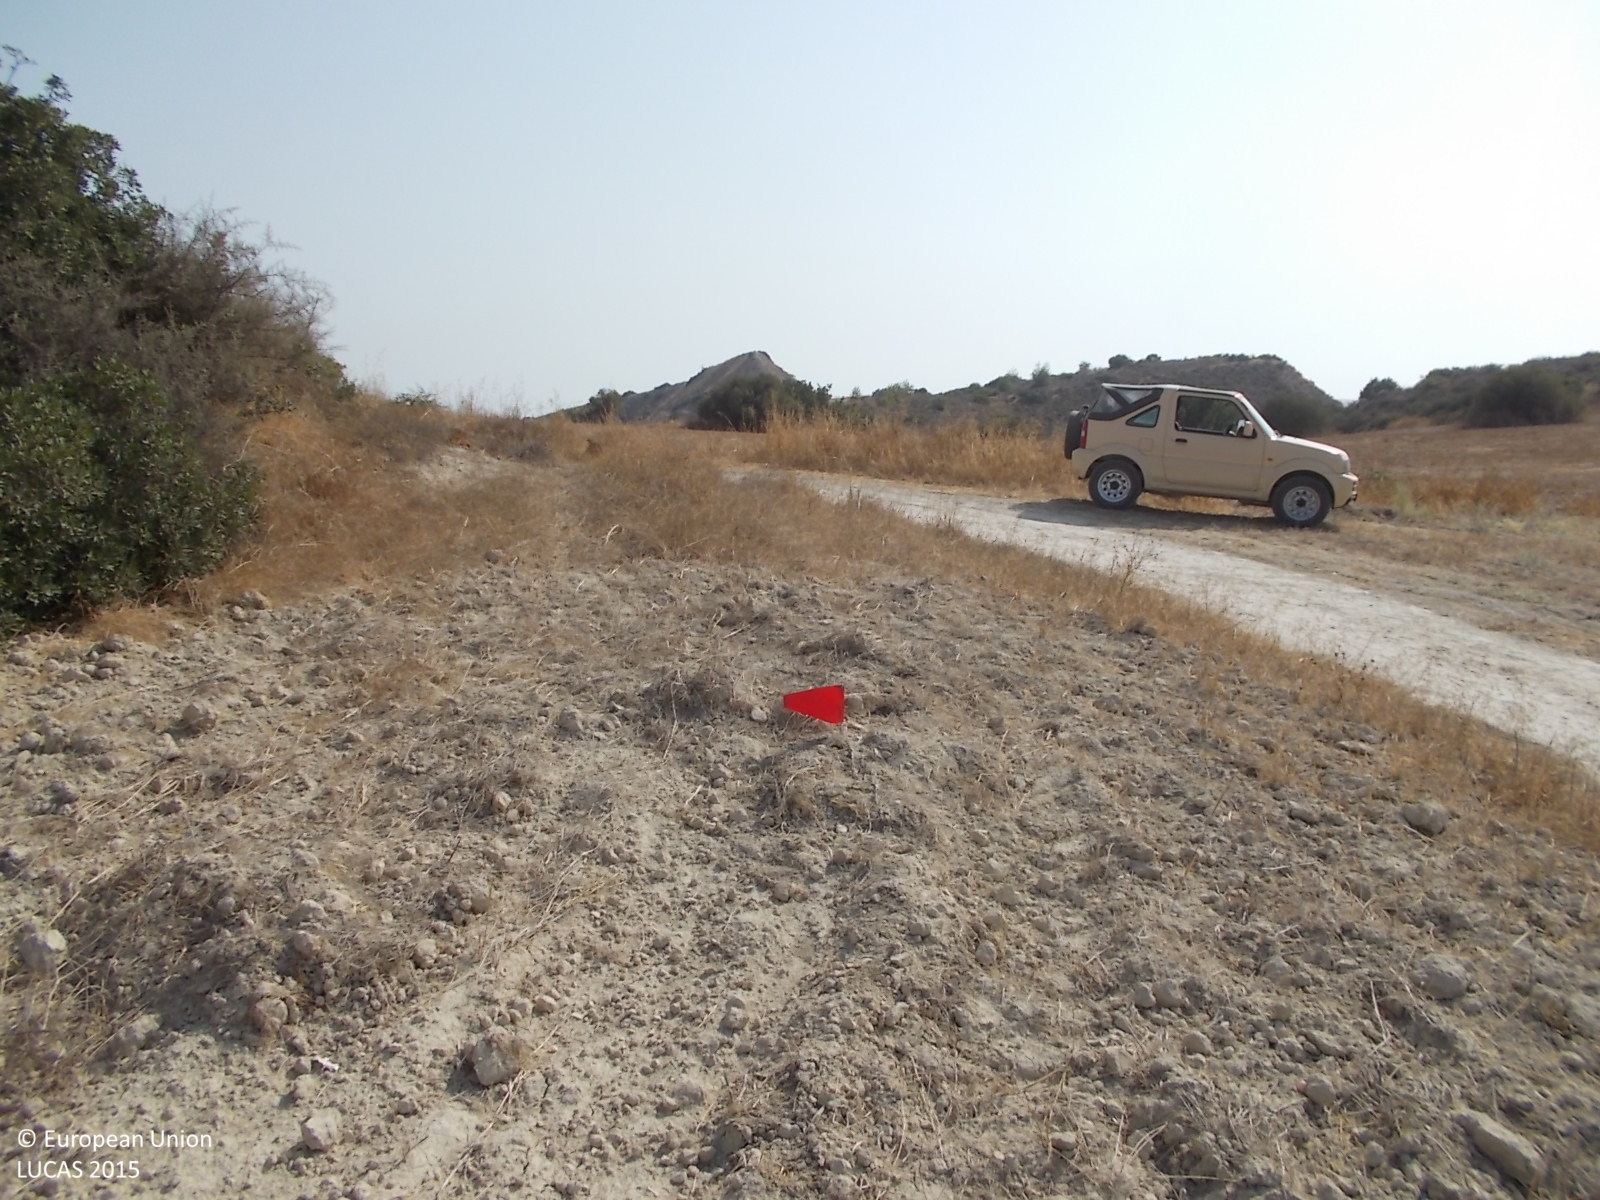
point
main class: Cropland
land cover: Oats
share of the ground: < 10 %
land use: Agriculture (excluding fallow land and kitchen gardens)
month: April
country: CY
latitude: 34.7706
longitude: 33.3094
